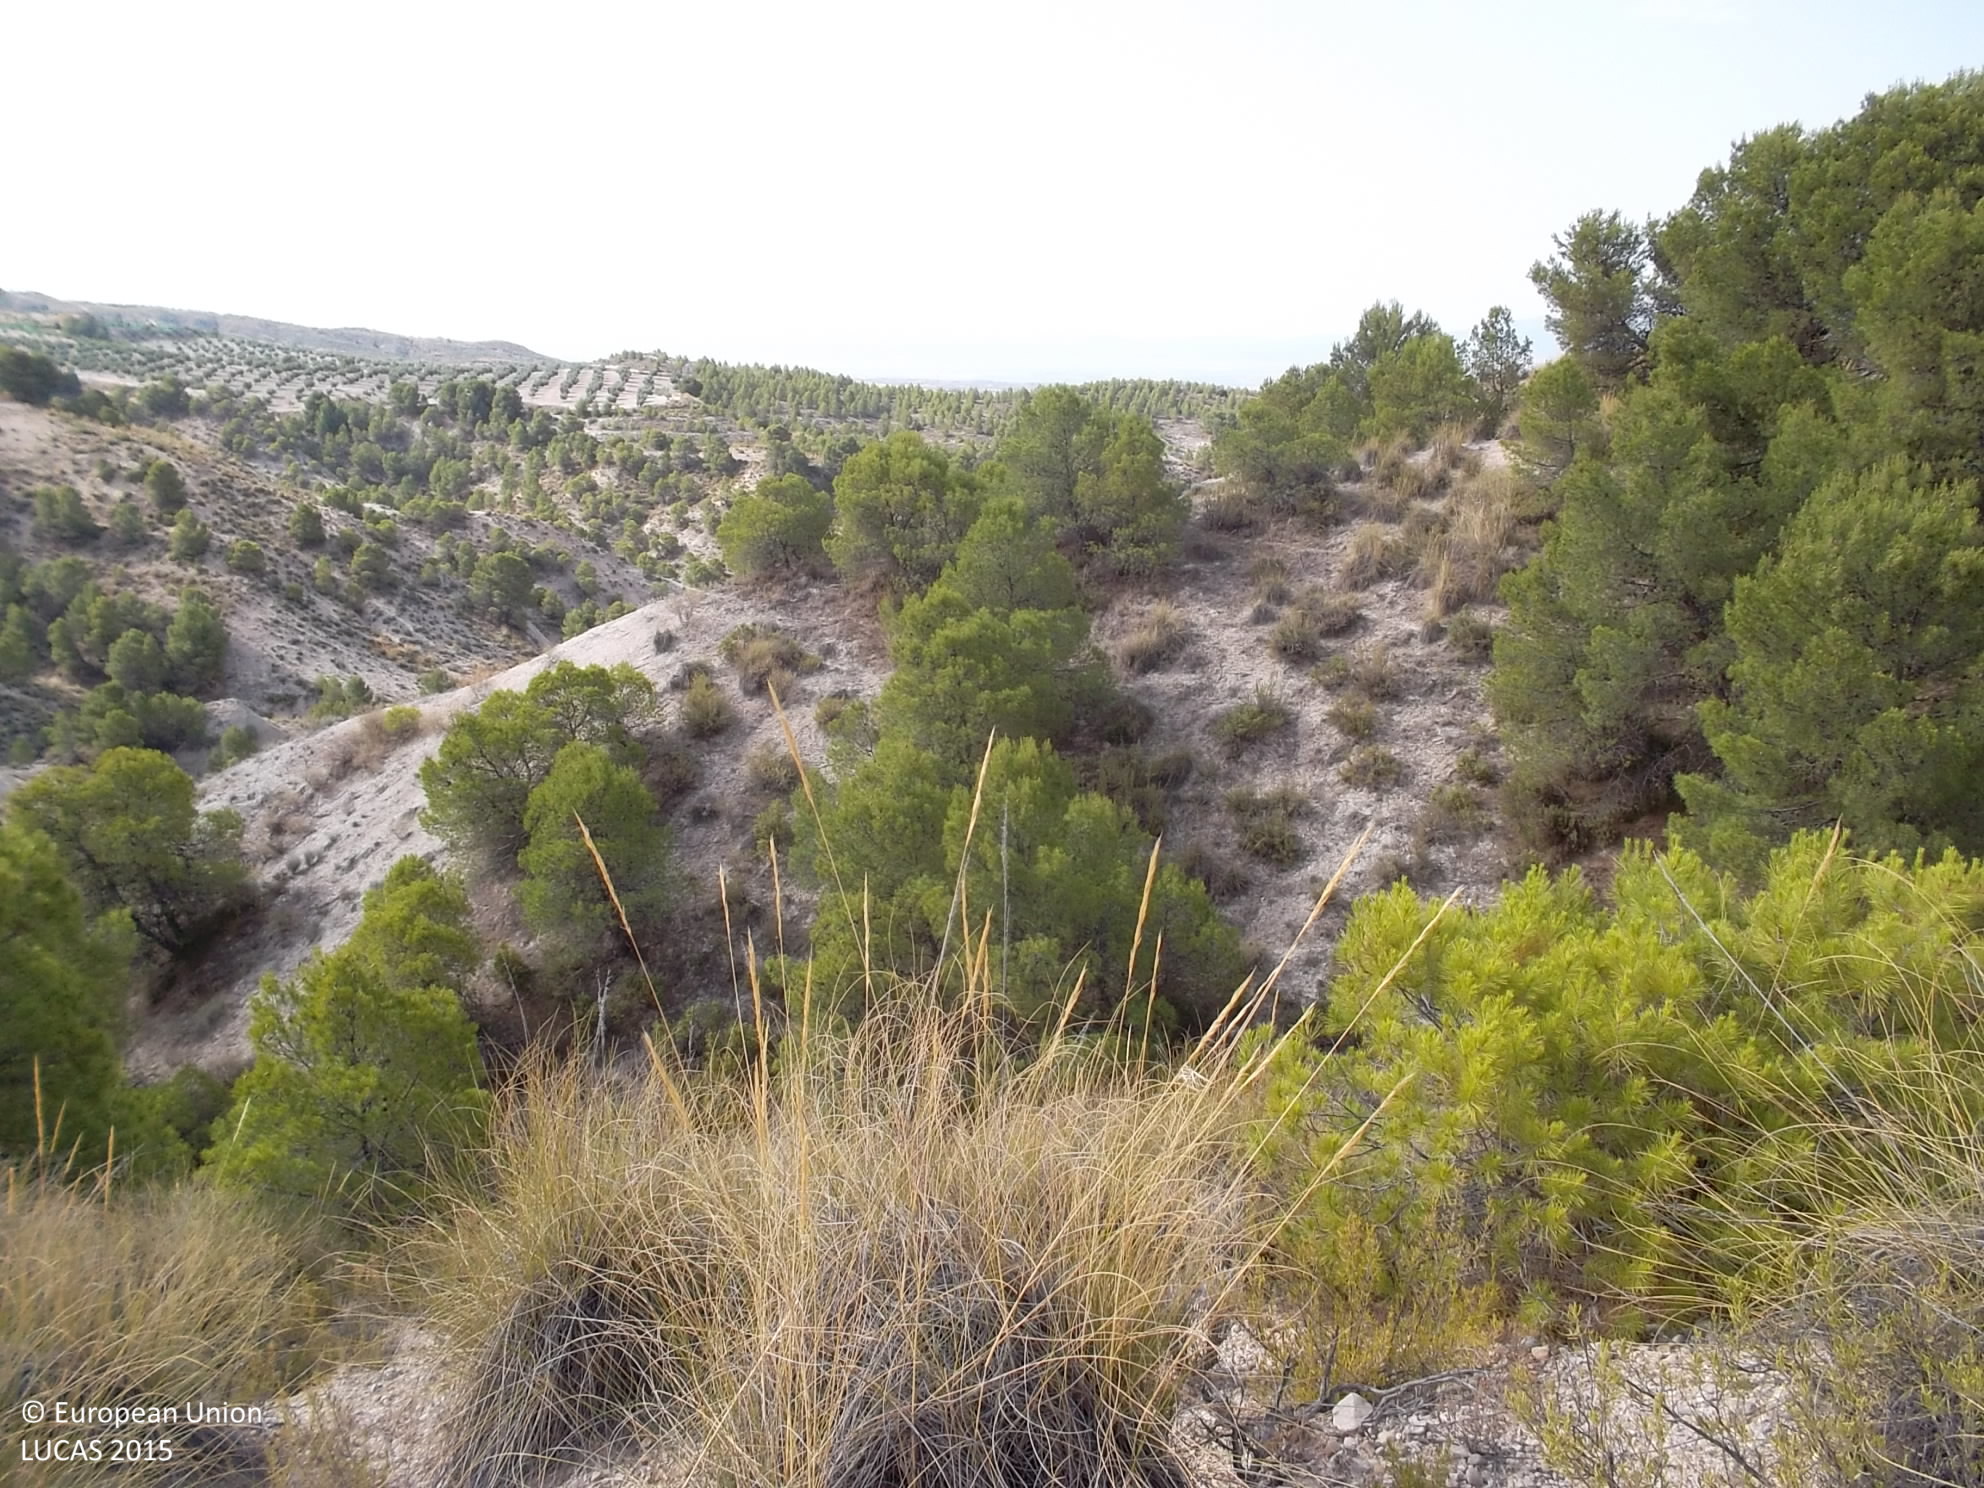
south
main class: Grassland
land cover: Grassland with sparse tree/shrub cover
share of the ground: > 75 %
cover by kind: herbaceous plants 90 %, coniferous forest trees 5 %, shrubs 5 %
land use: Semi-natural and natural areas not in use
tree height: > 5 m
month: July
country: ES
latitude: 37.6894
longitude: -2.7704
